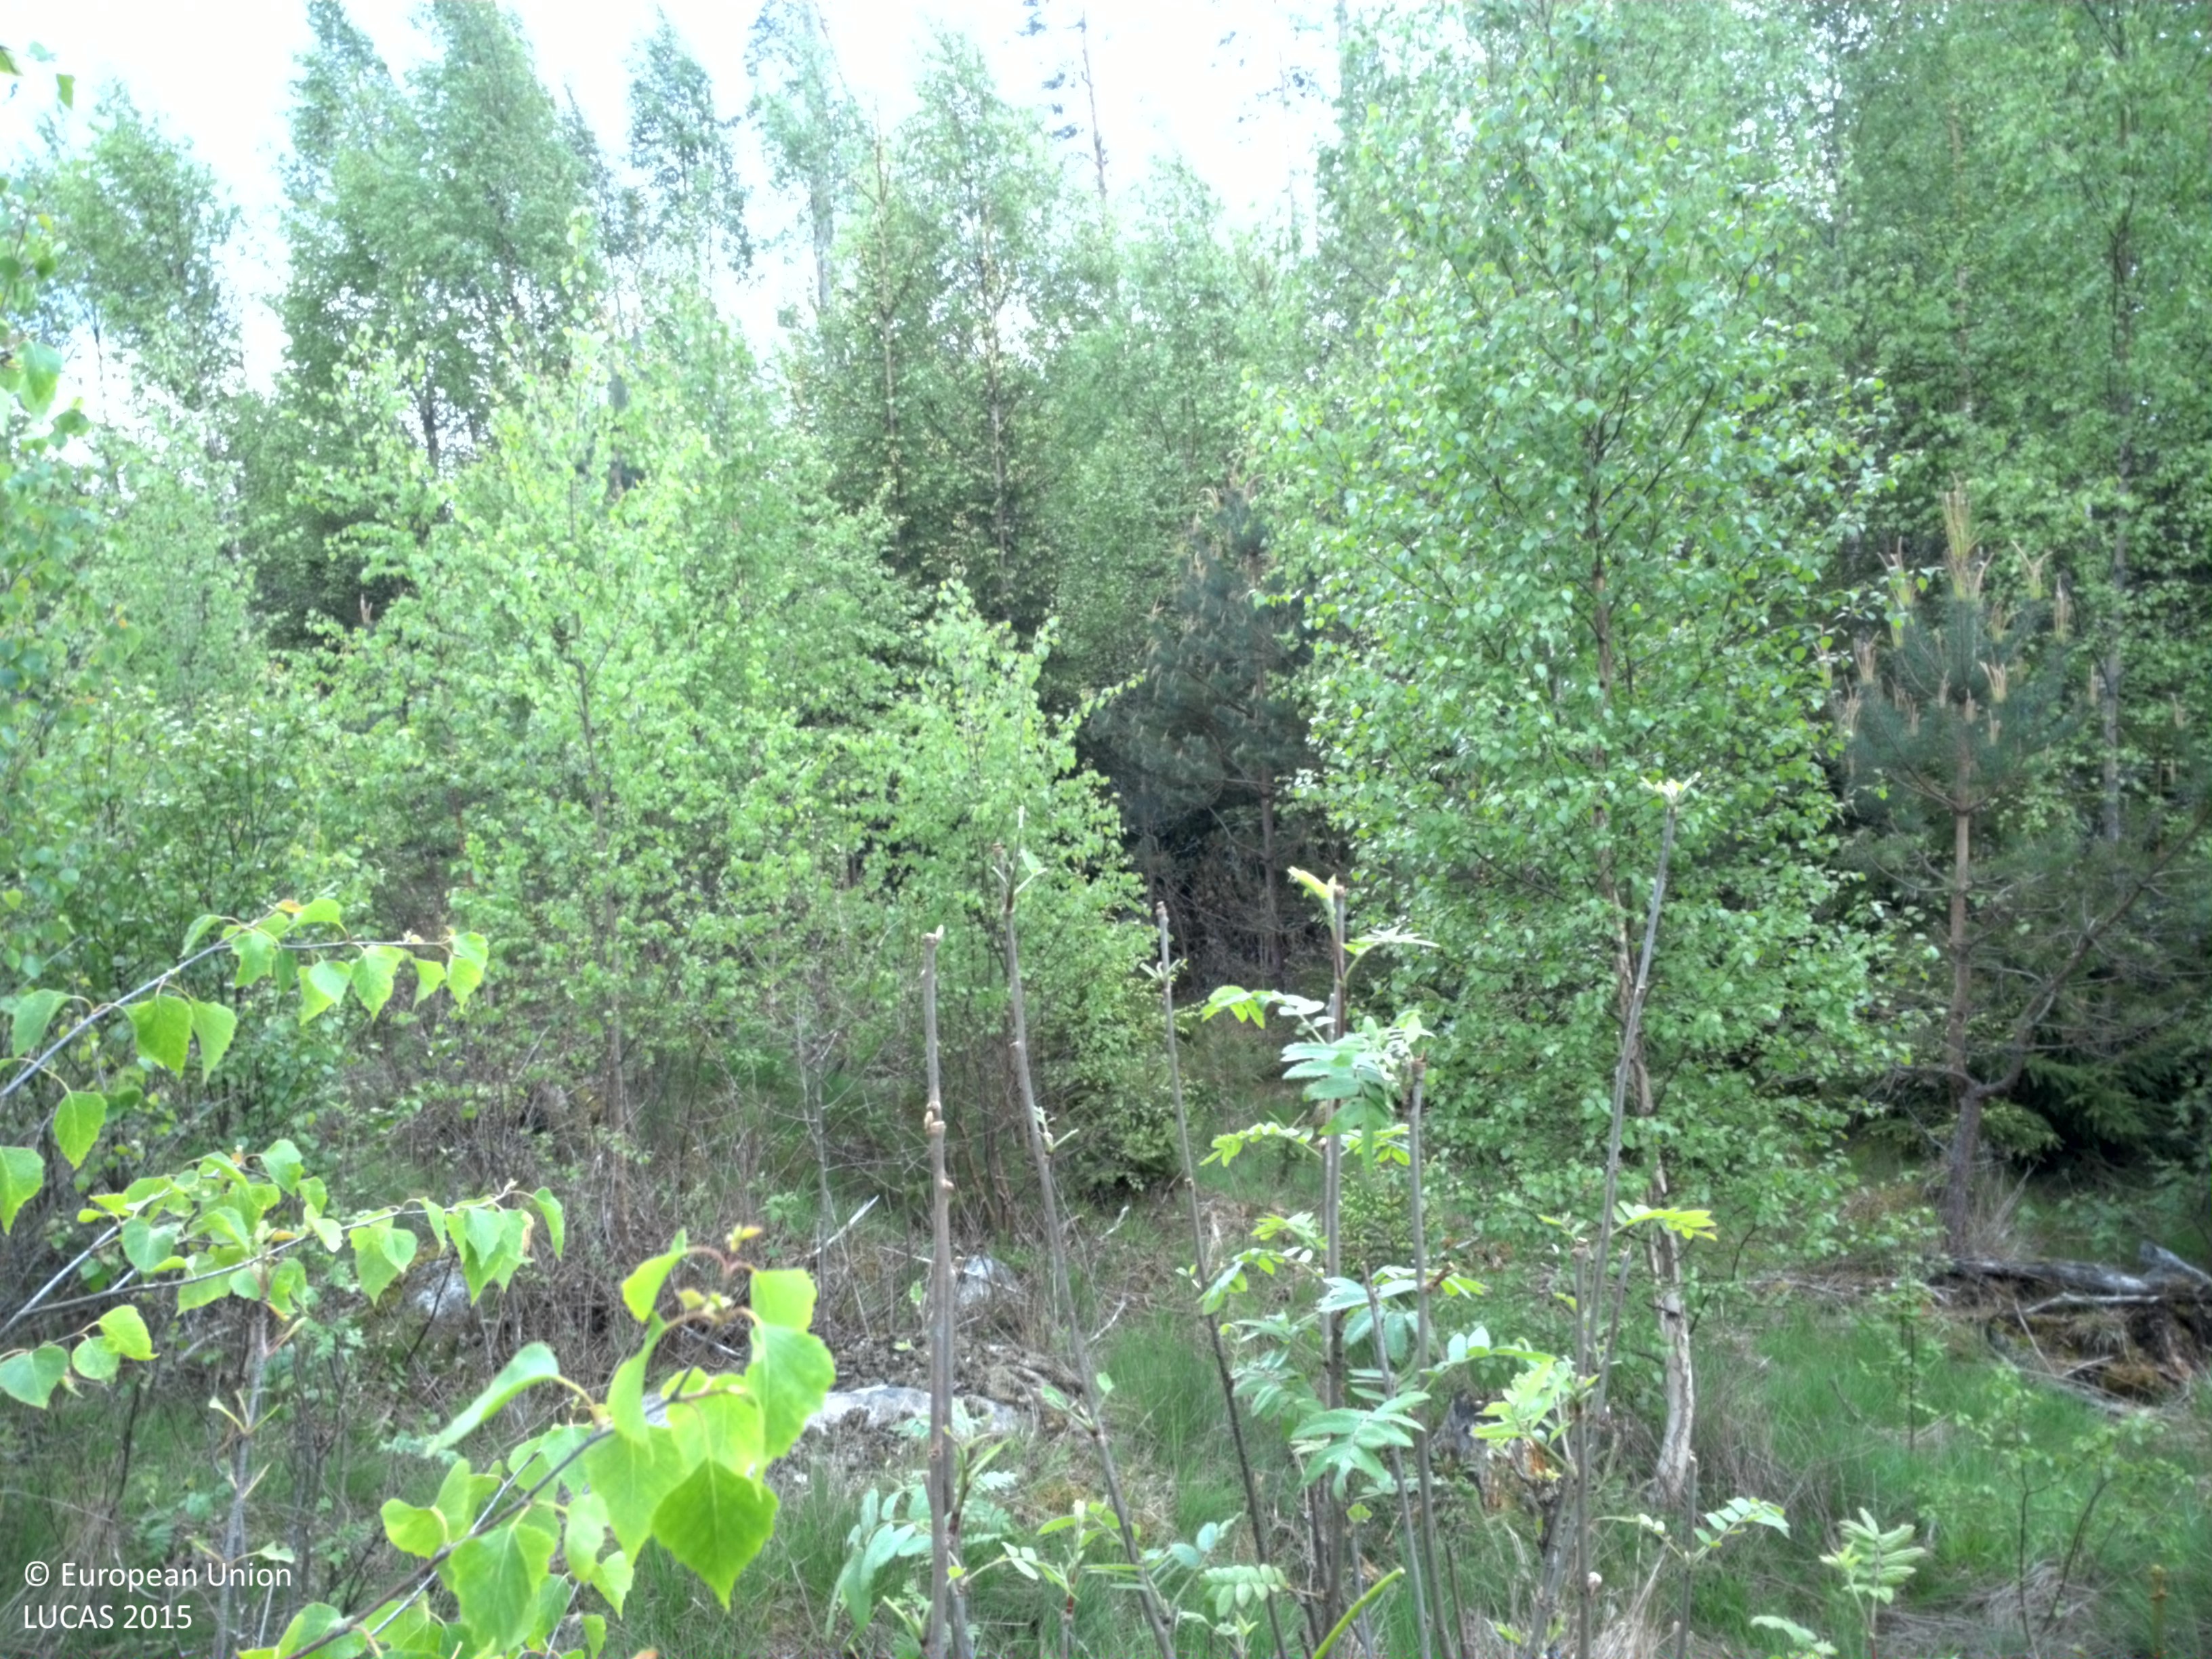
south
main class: Woodland
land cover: Spruce dominated mixed woodland
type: boreal forest
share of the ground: 50 - 75 %
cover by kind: broadleaved forest trees 35 %, coniferous forest trees 25 %, herbaceous plants 25 %, shrubs 10 %, lichens and mosses 5 %
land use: Forestry
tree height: < 5 m
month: June
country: SE
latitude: 56.8178
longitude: 14.3054
